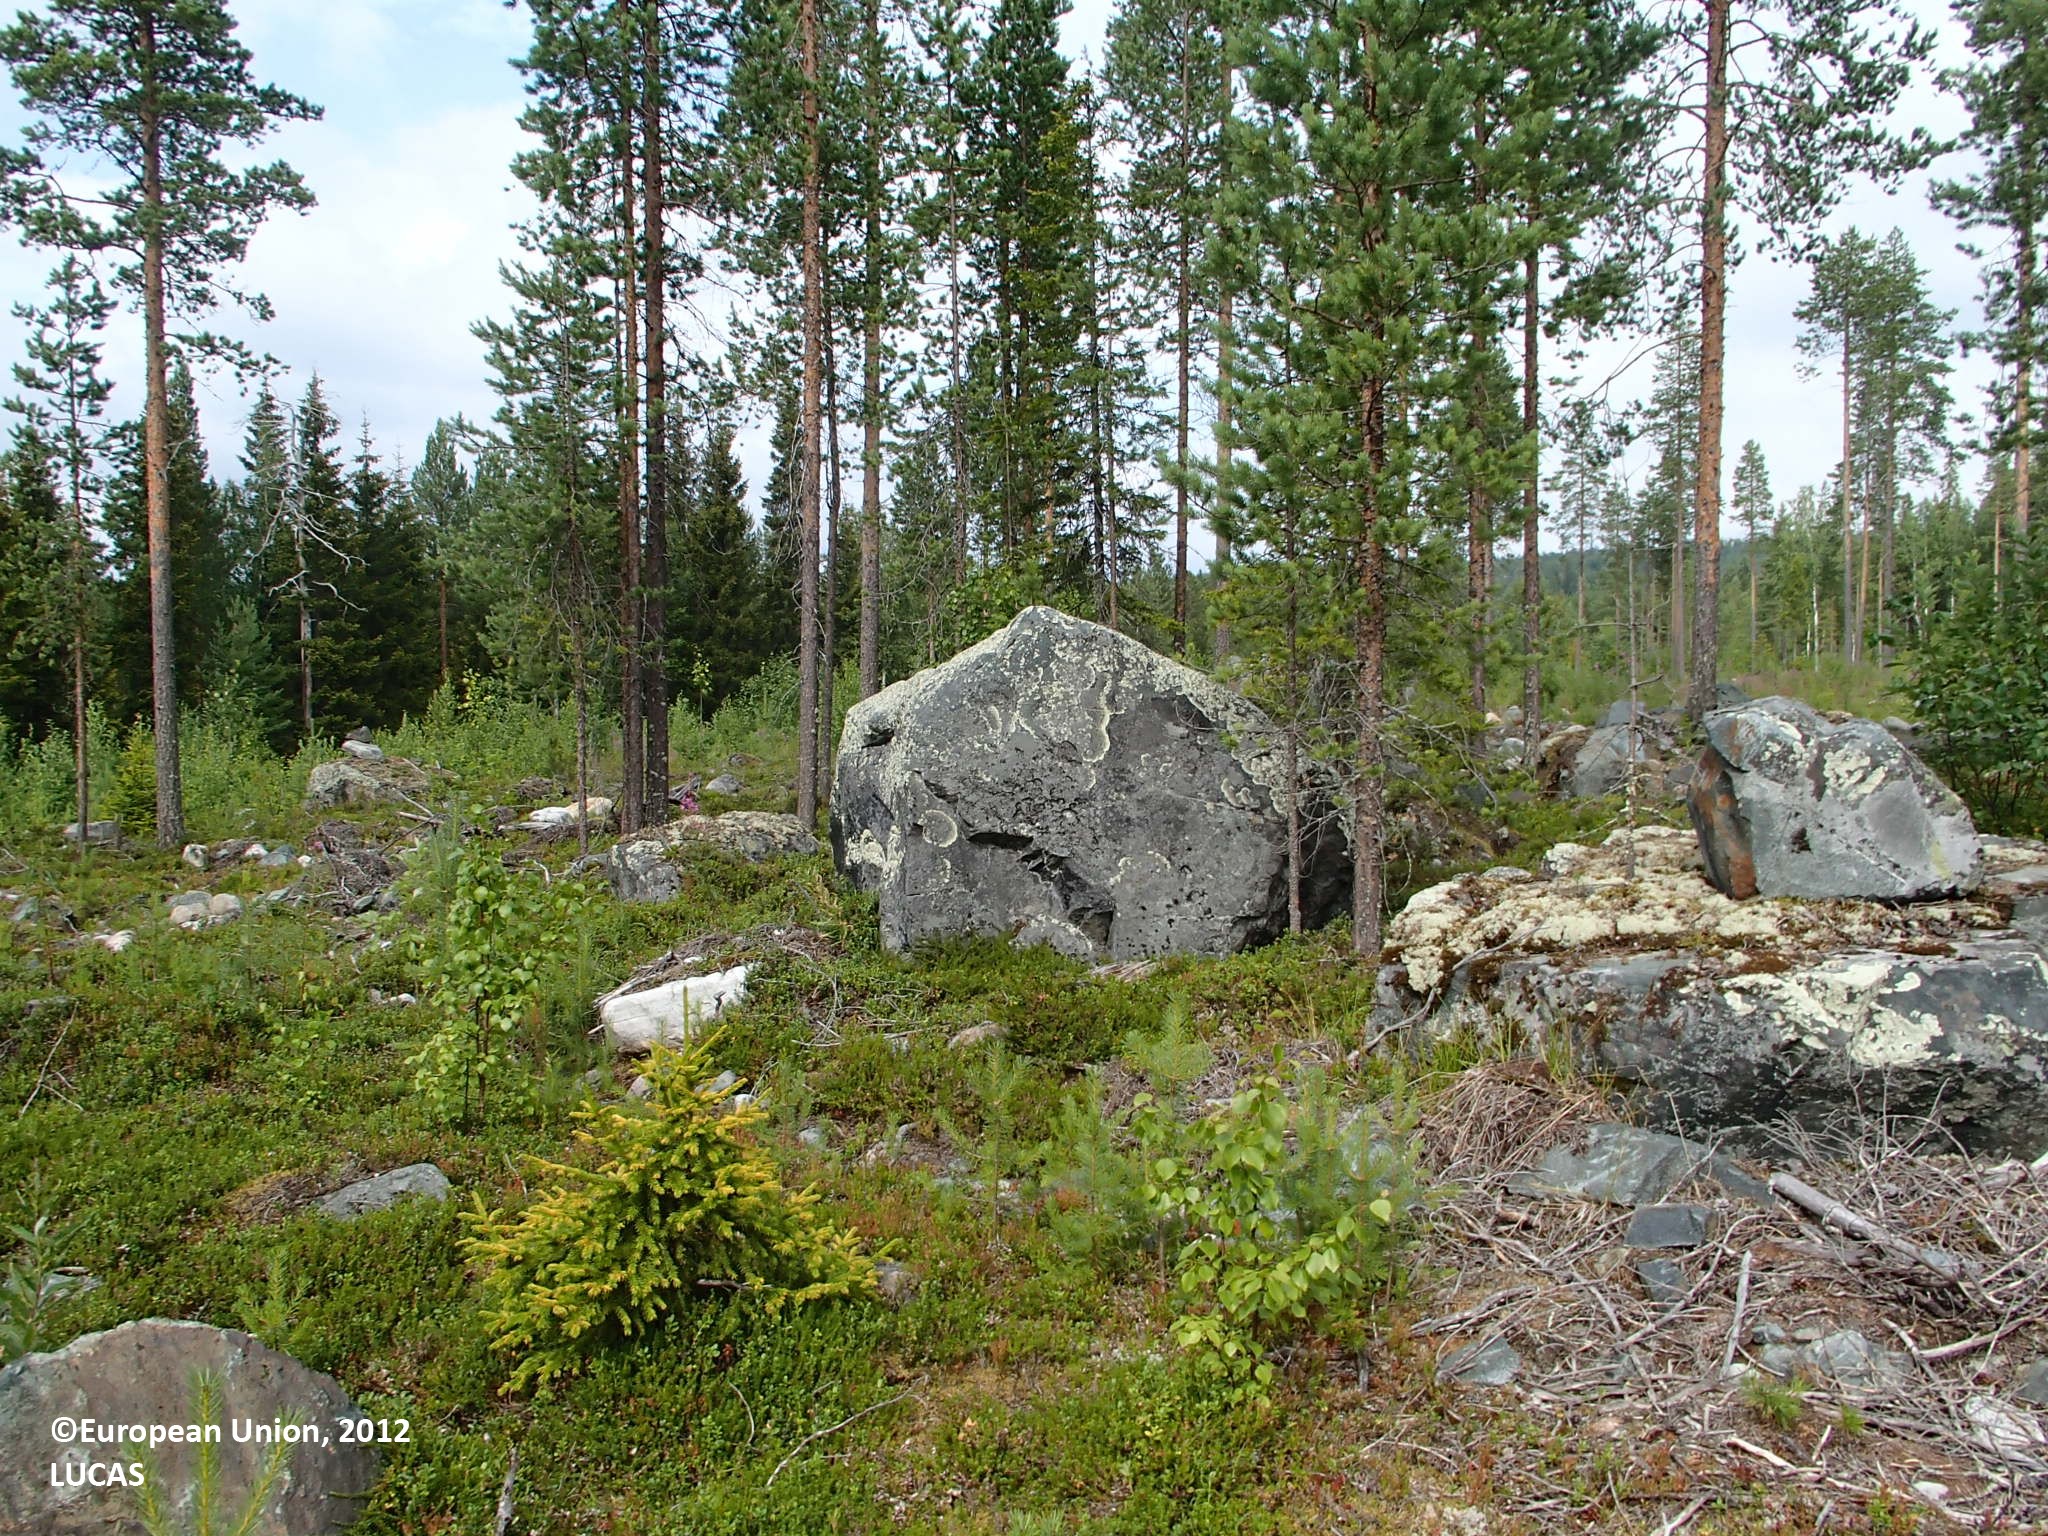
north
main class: Woodland
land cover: Pine dominated coniferous woodland
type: boreal forest
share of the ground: 10 - 25 %
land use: Forestry
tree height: > 5 m
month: July
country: FI
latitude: 66.1965
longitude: 25.3639
